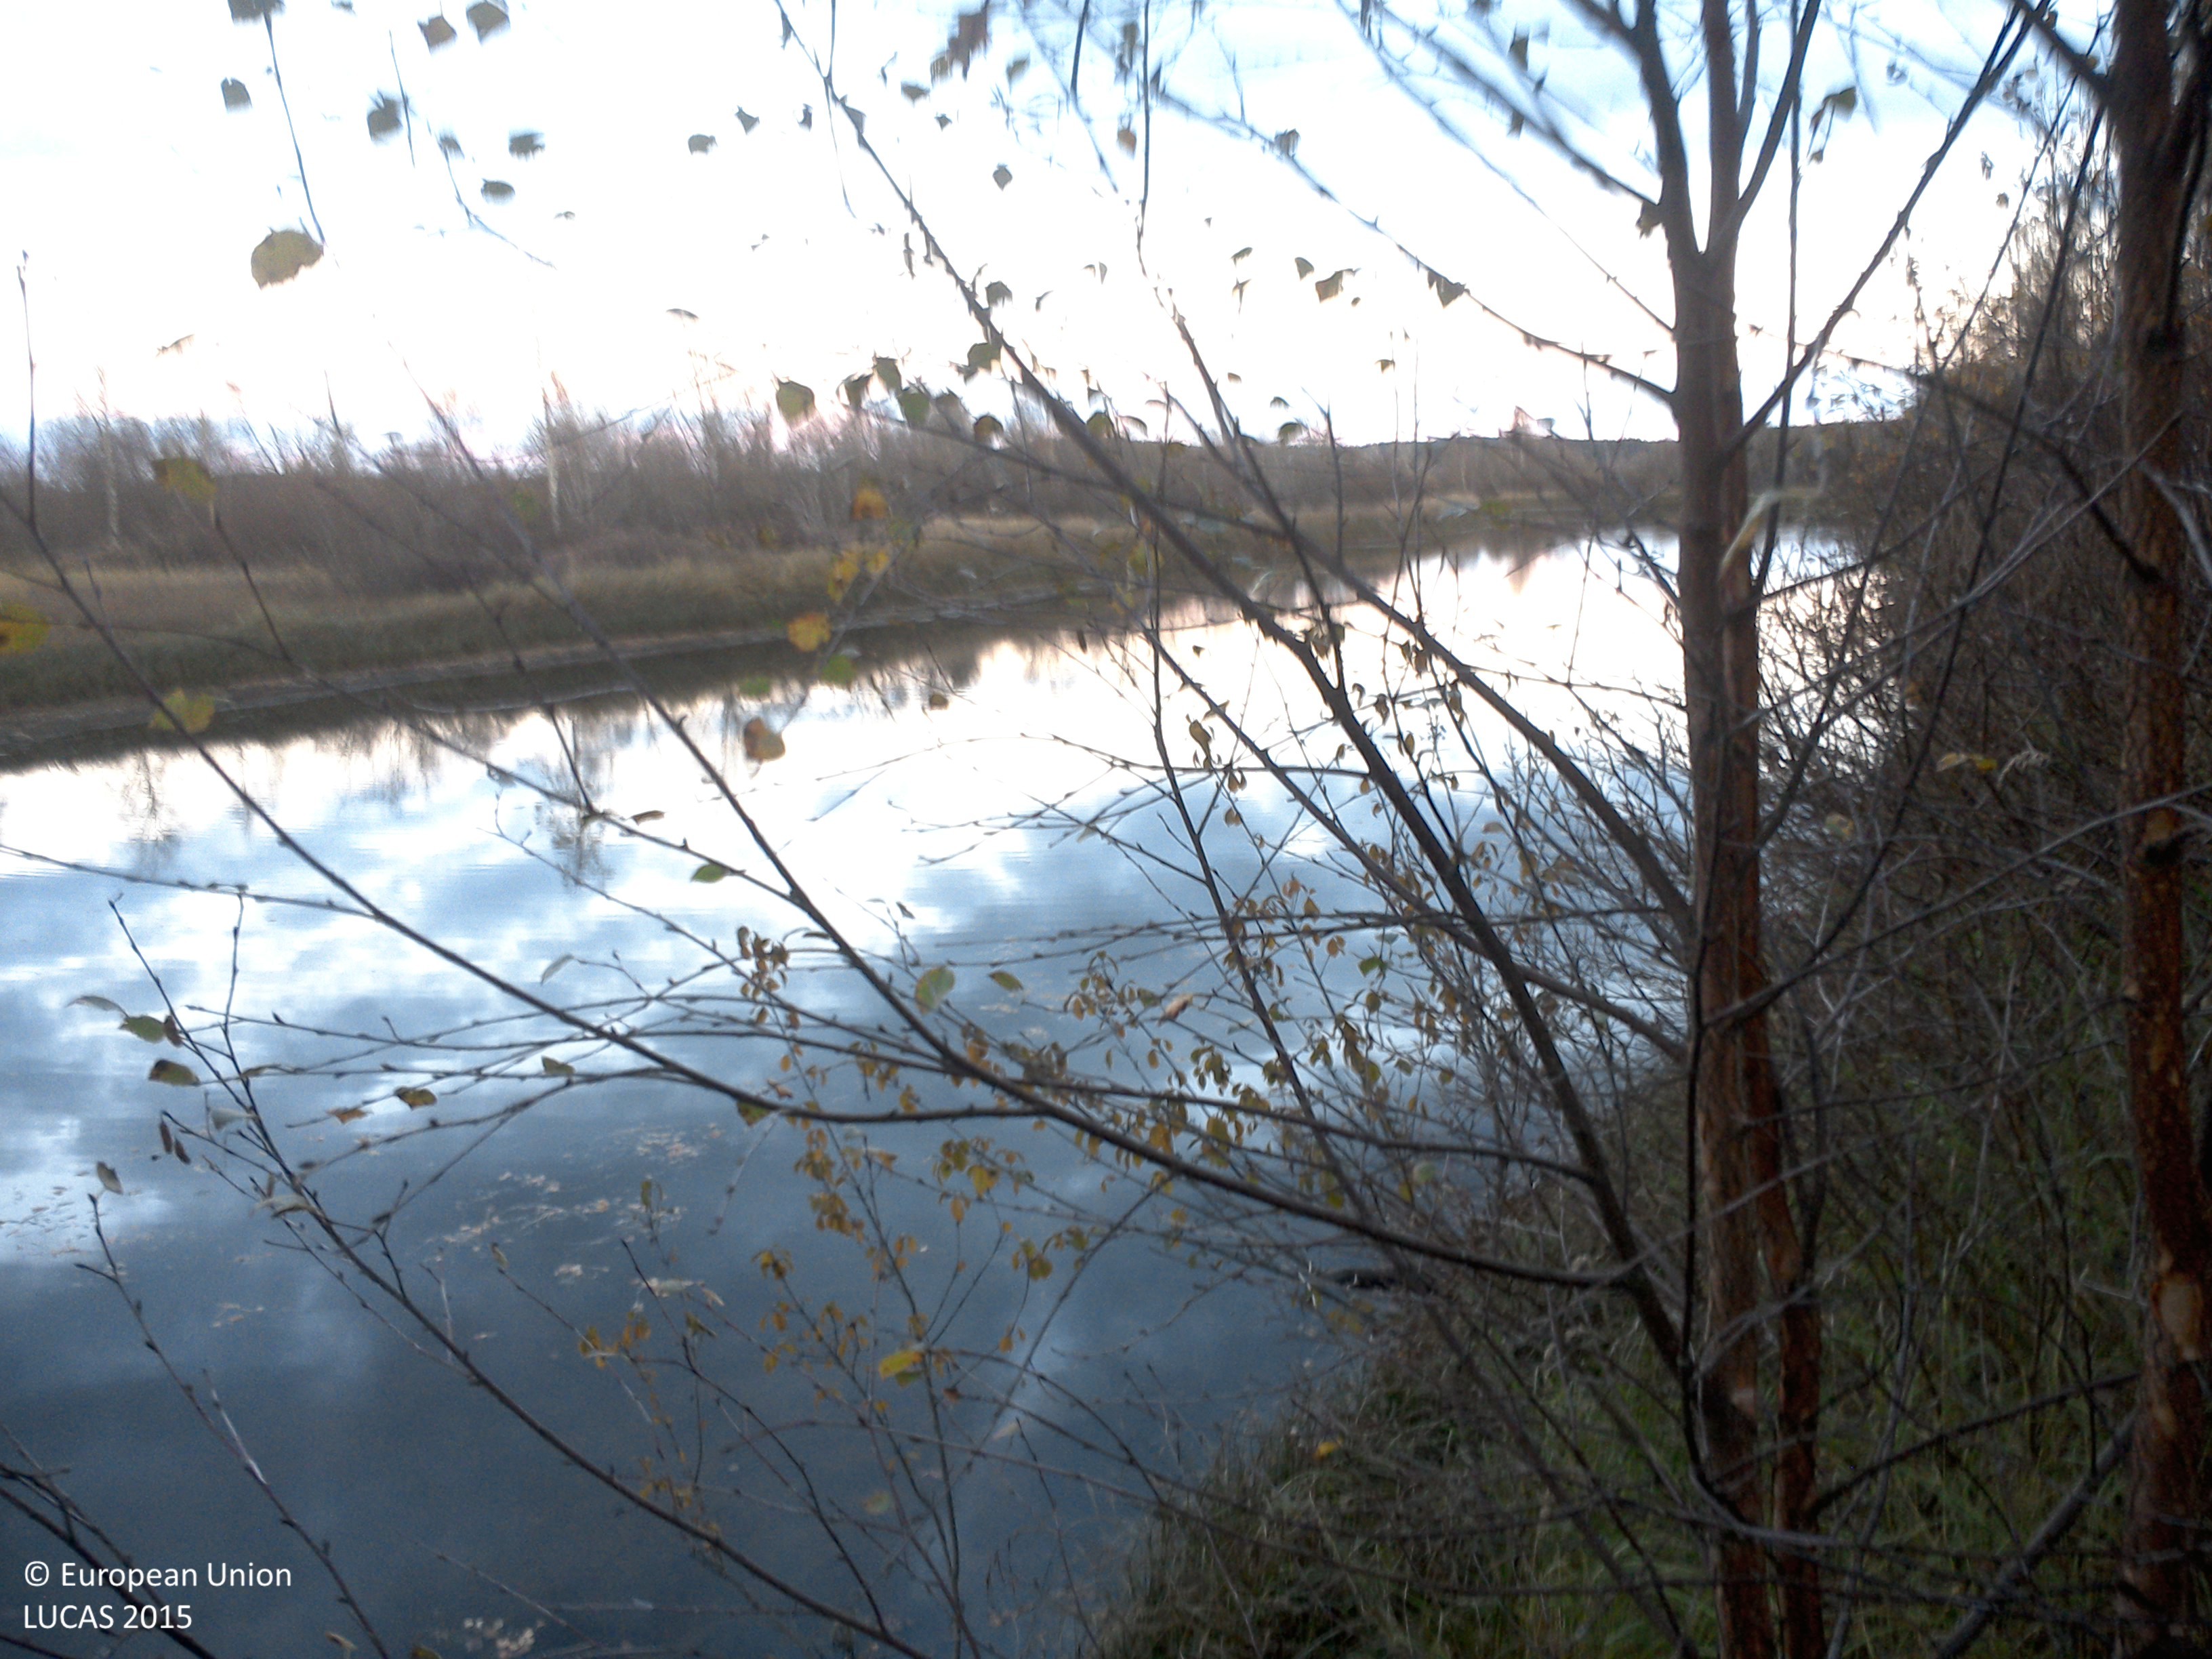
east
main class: Woodland
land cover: Broadleaved woodland
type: boreal forest
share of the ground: 25 - 50 %
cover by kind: herbaceous plants 60 %, broadleaved forest trees 40 %
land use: Semi-natural and natural areas not in use
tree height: > 5 m
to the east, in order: Broadleaved woodland; Other bare soil; Inland fresh running water
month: October
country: SE
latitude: 63.8880
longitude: 19.8965
